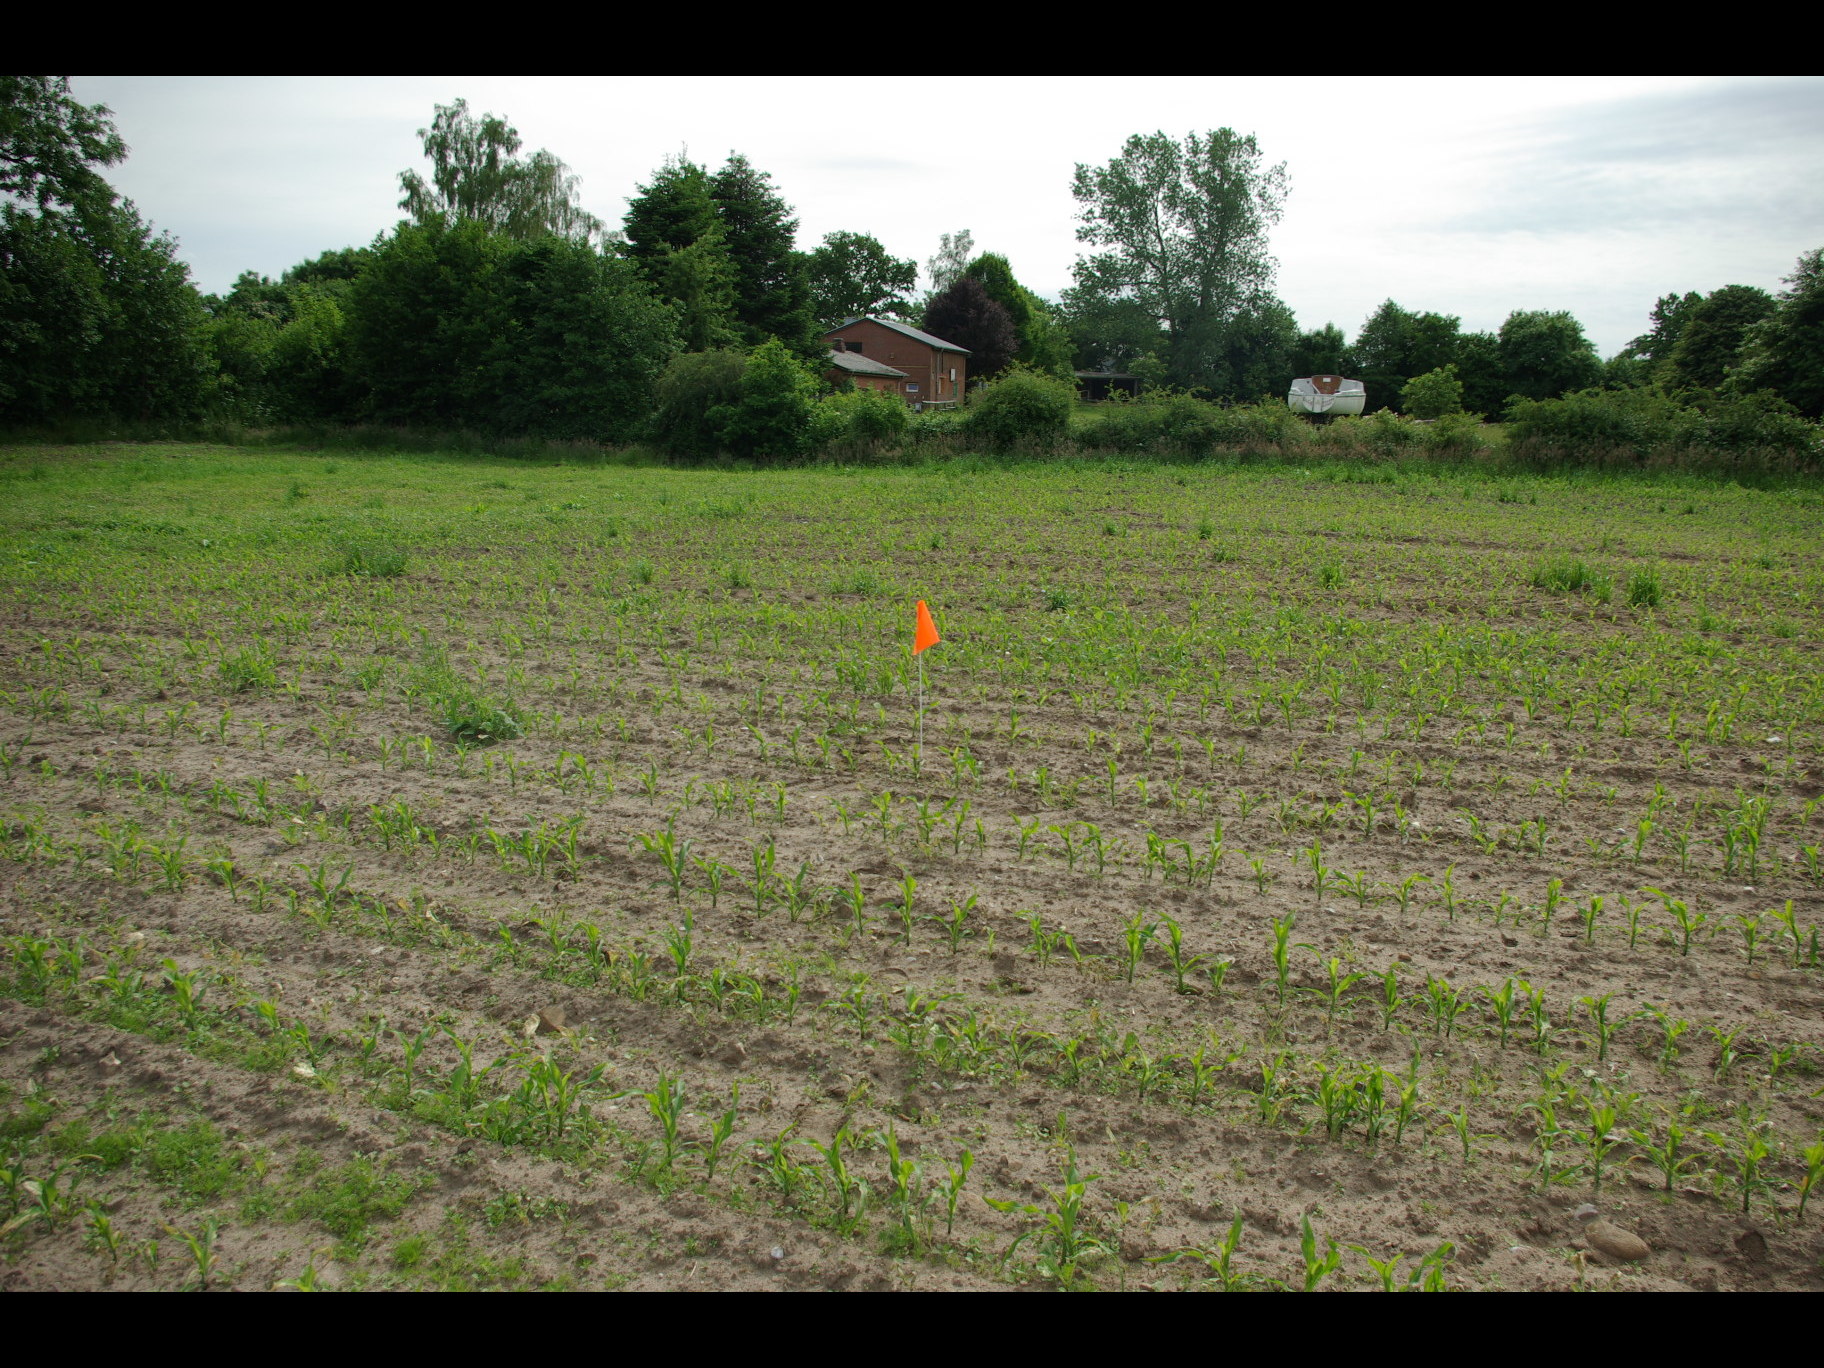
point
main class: Cropland
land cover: Maize
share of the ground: 10 - 25 %
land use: Agriculture (excluding fallow land and kitchen gardens)
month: June
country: DE
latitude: 54.4258
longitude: 9.6457
